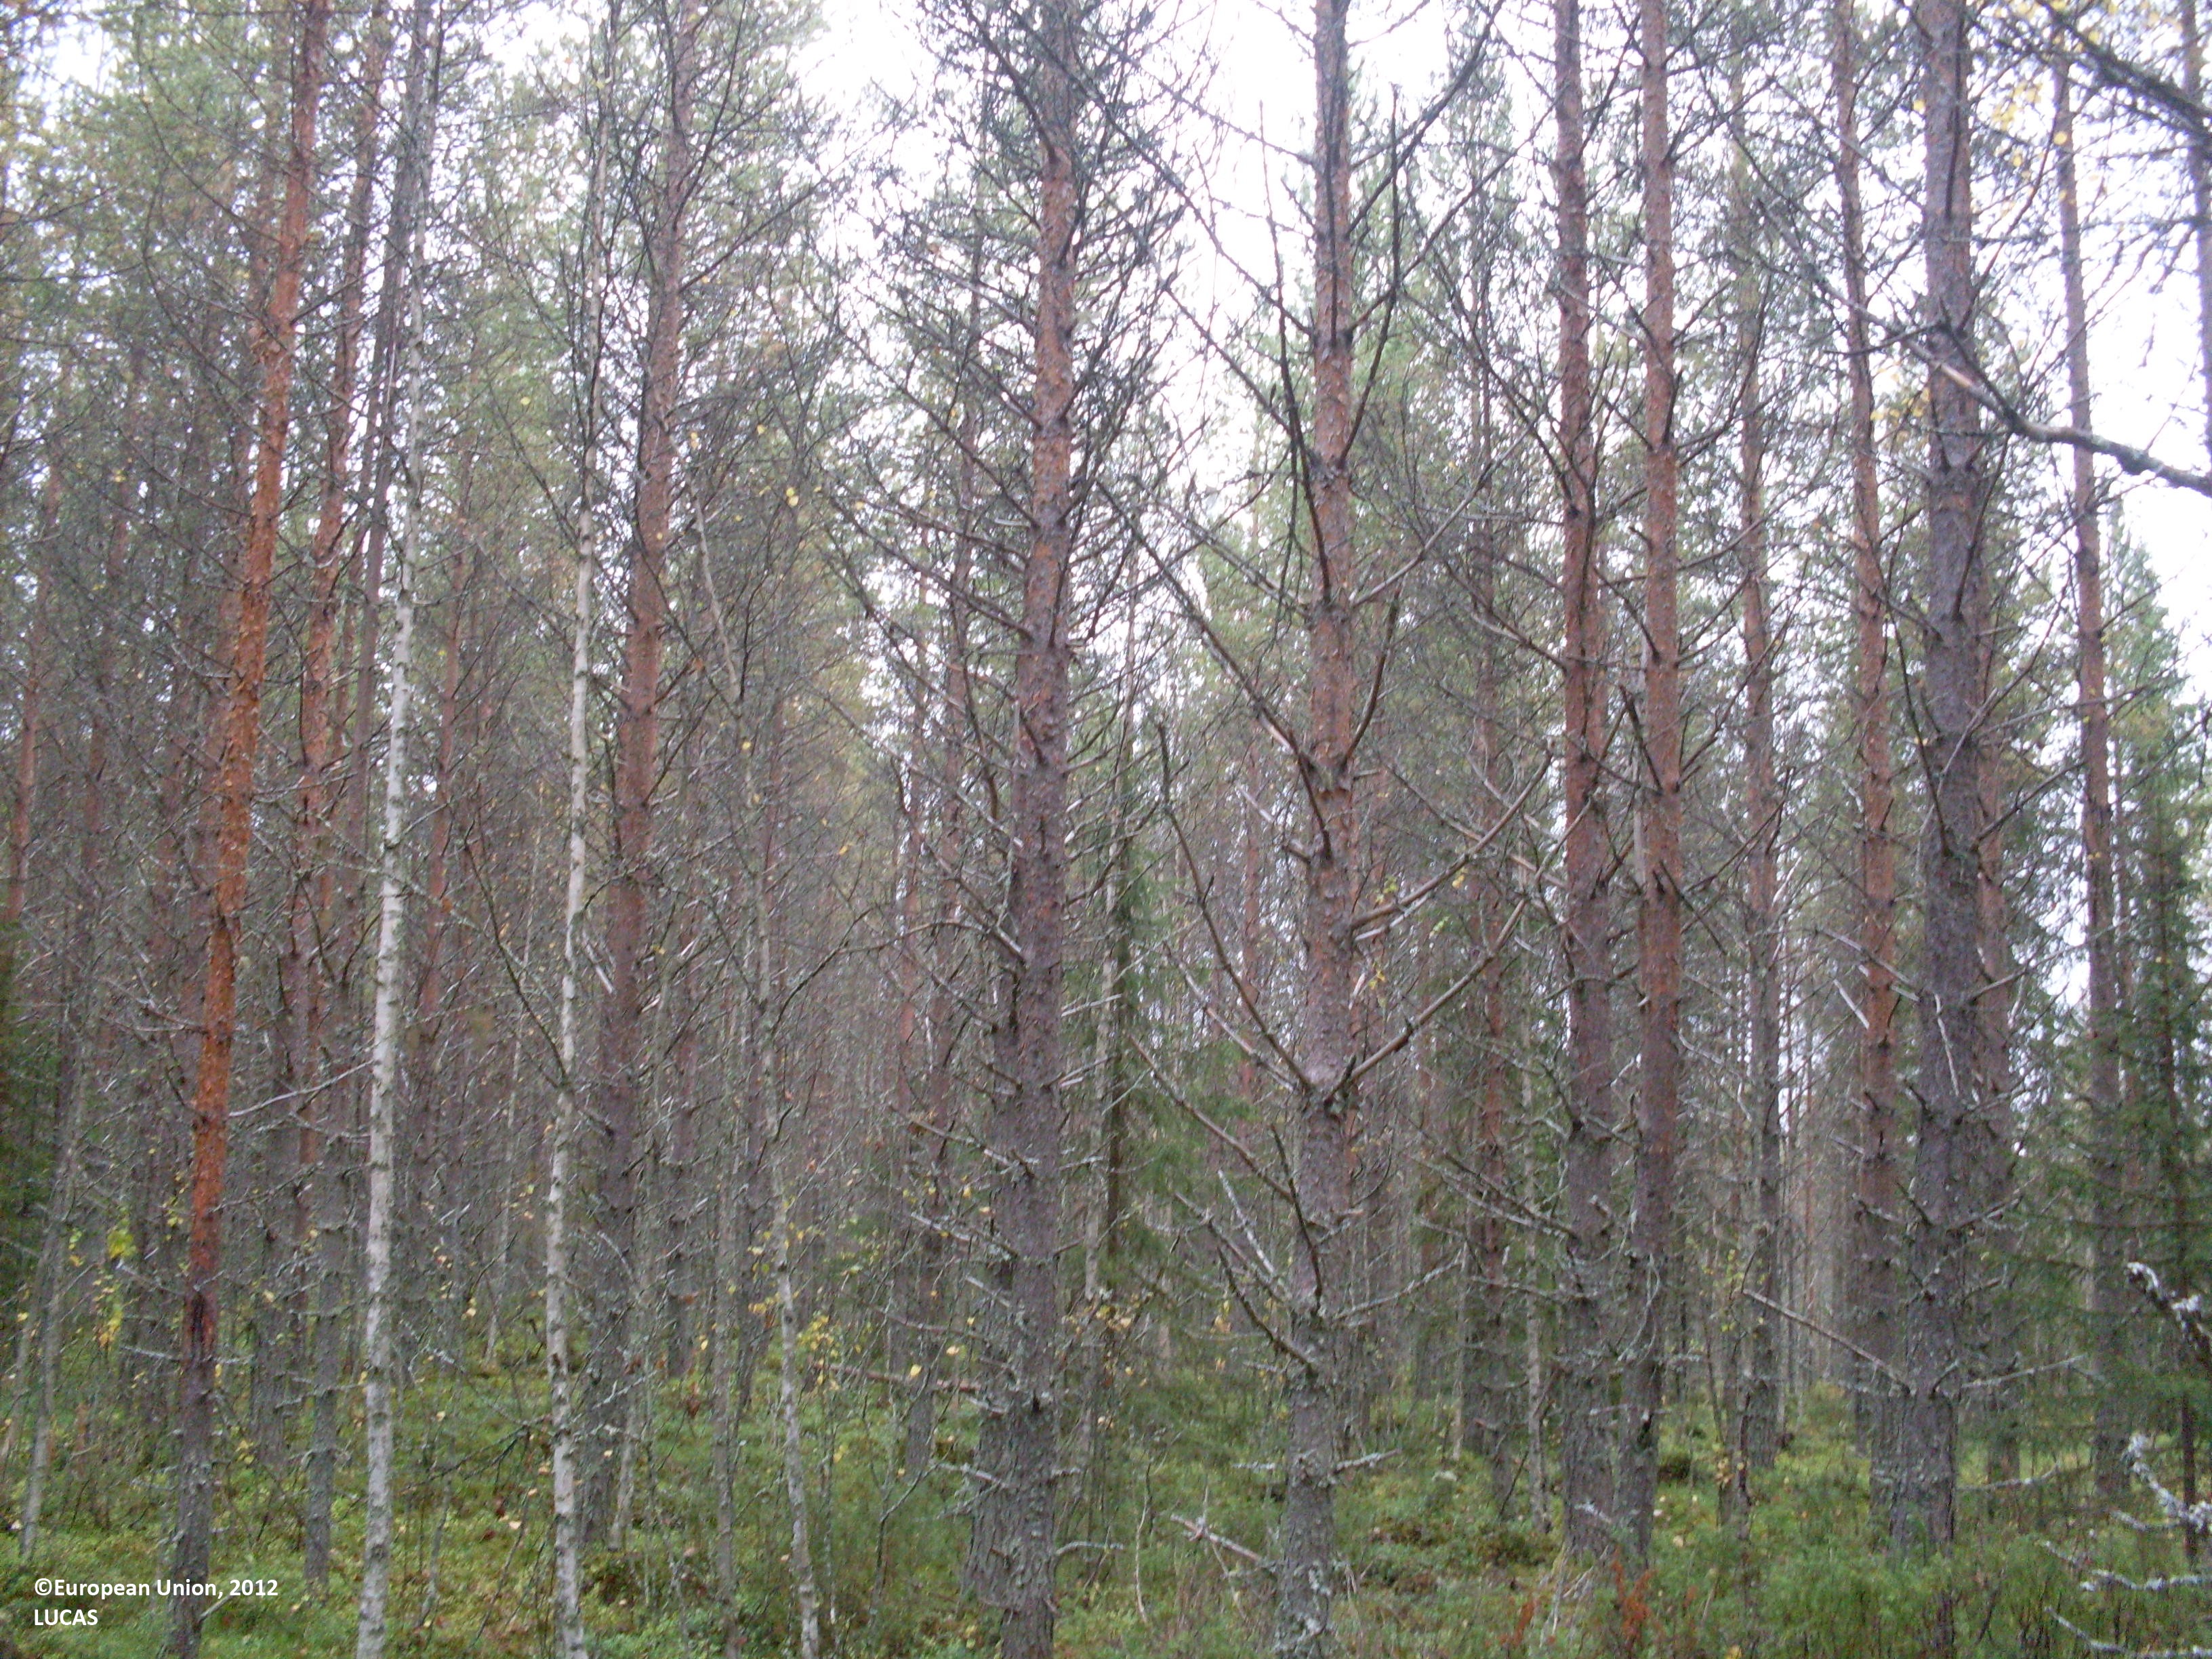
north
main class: Woodland
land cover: Pine dominated mixed woodland
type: boreal forest
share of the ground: 50 - 75 %
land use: Forestry
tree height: > 5 m
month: September
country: FI
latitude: 64.5670
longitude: 28.4769
